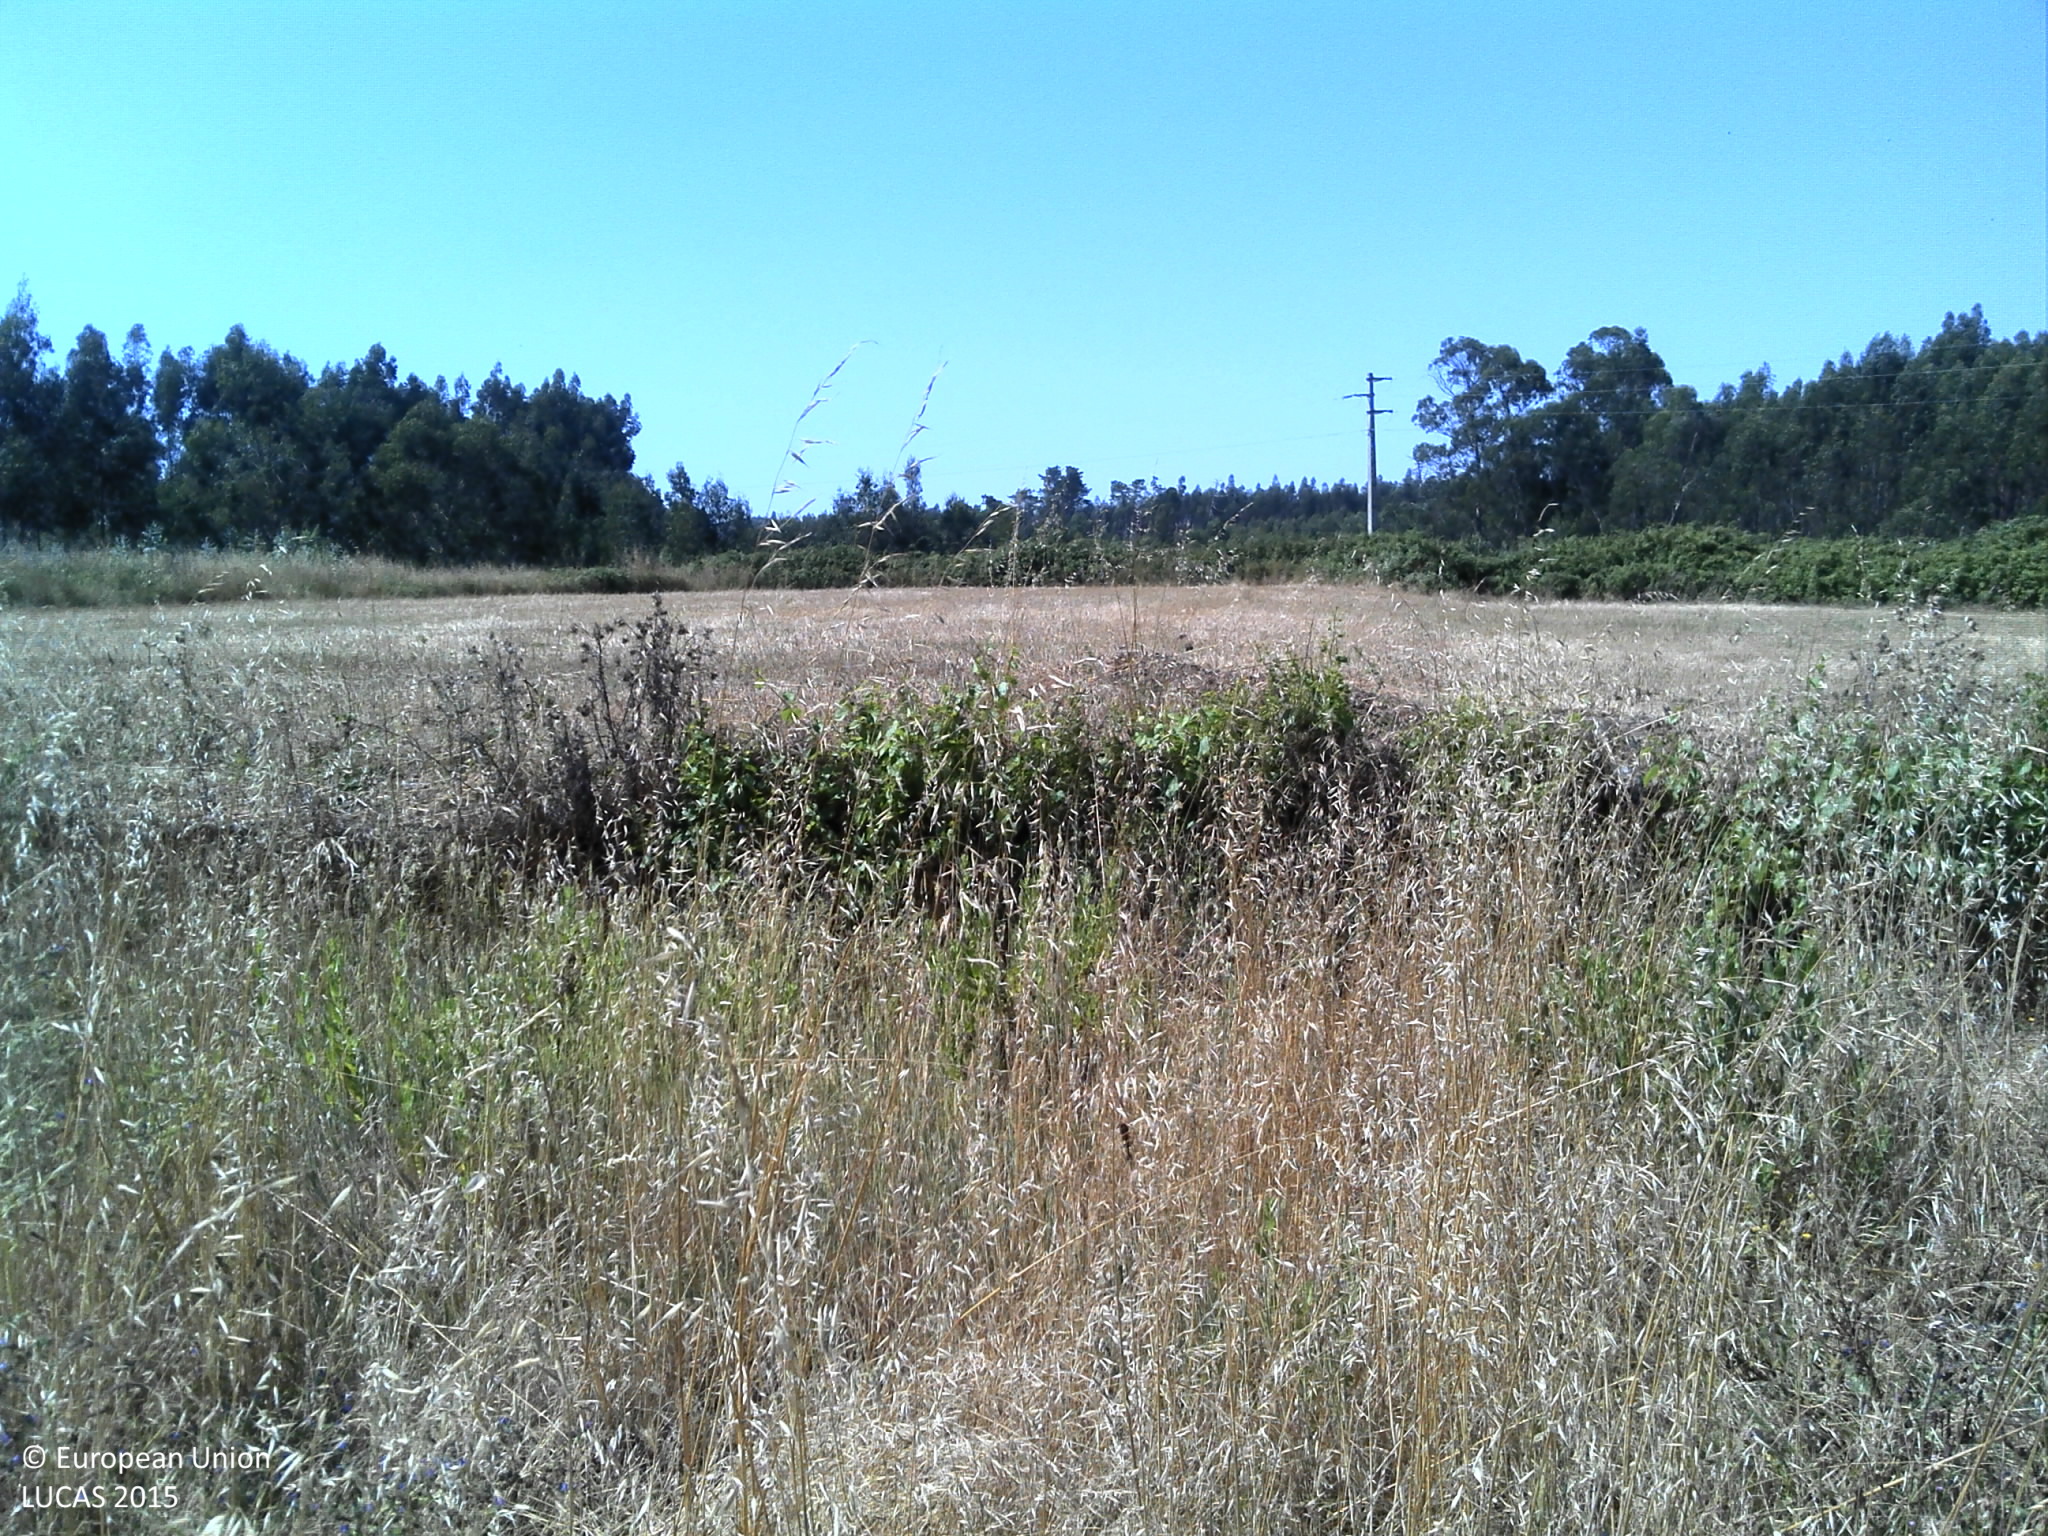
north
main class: Grassland
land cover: Spontaneously vegetated surfaces
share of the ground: > 75 %
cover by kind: herbaceous plants 80 %, unconsolidated bare surface 20 %
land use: Fallow land
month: June
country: PT
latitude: 39.1712
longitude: -9.2673
